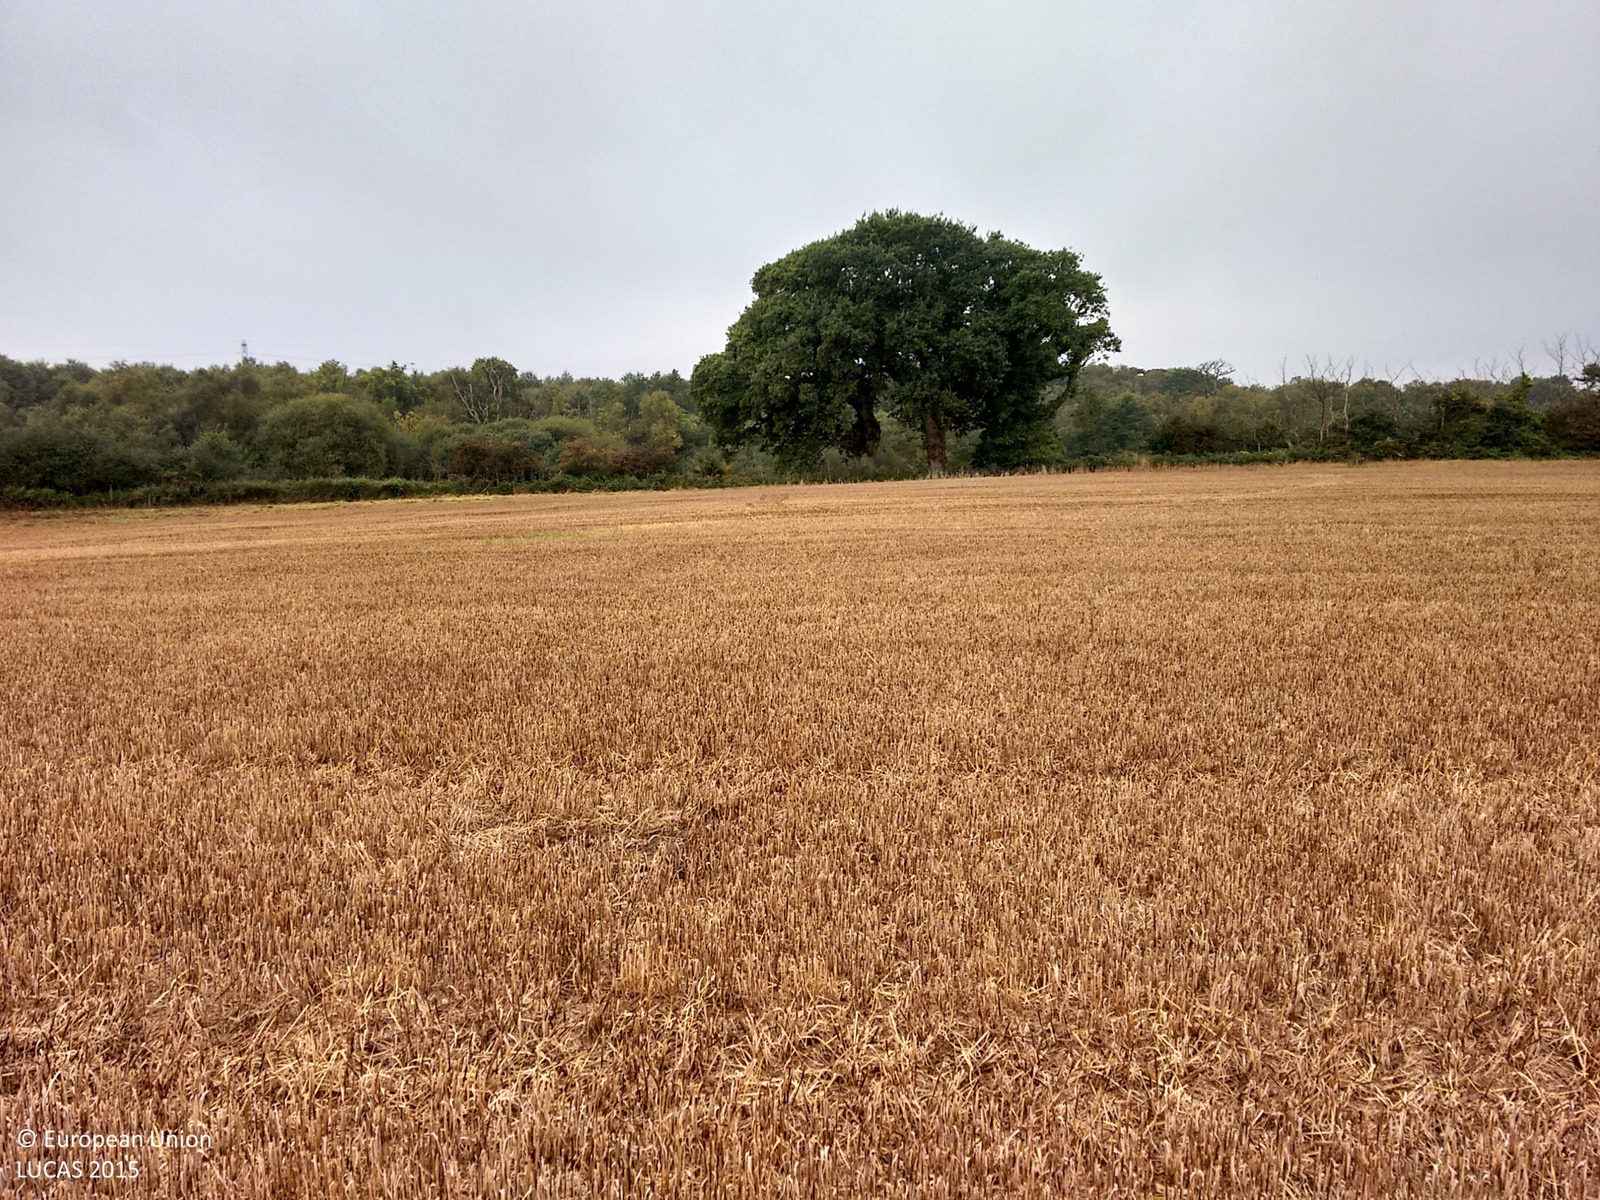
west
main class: Cropland
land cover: Common wheat
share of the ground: > 75 %
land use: Agriculture (excluding fallow land and kitchen gardens)
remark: Harvested field
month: October
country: GB
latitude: 52.5391
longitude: 1.7112
